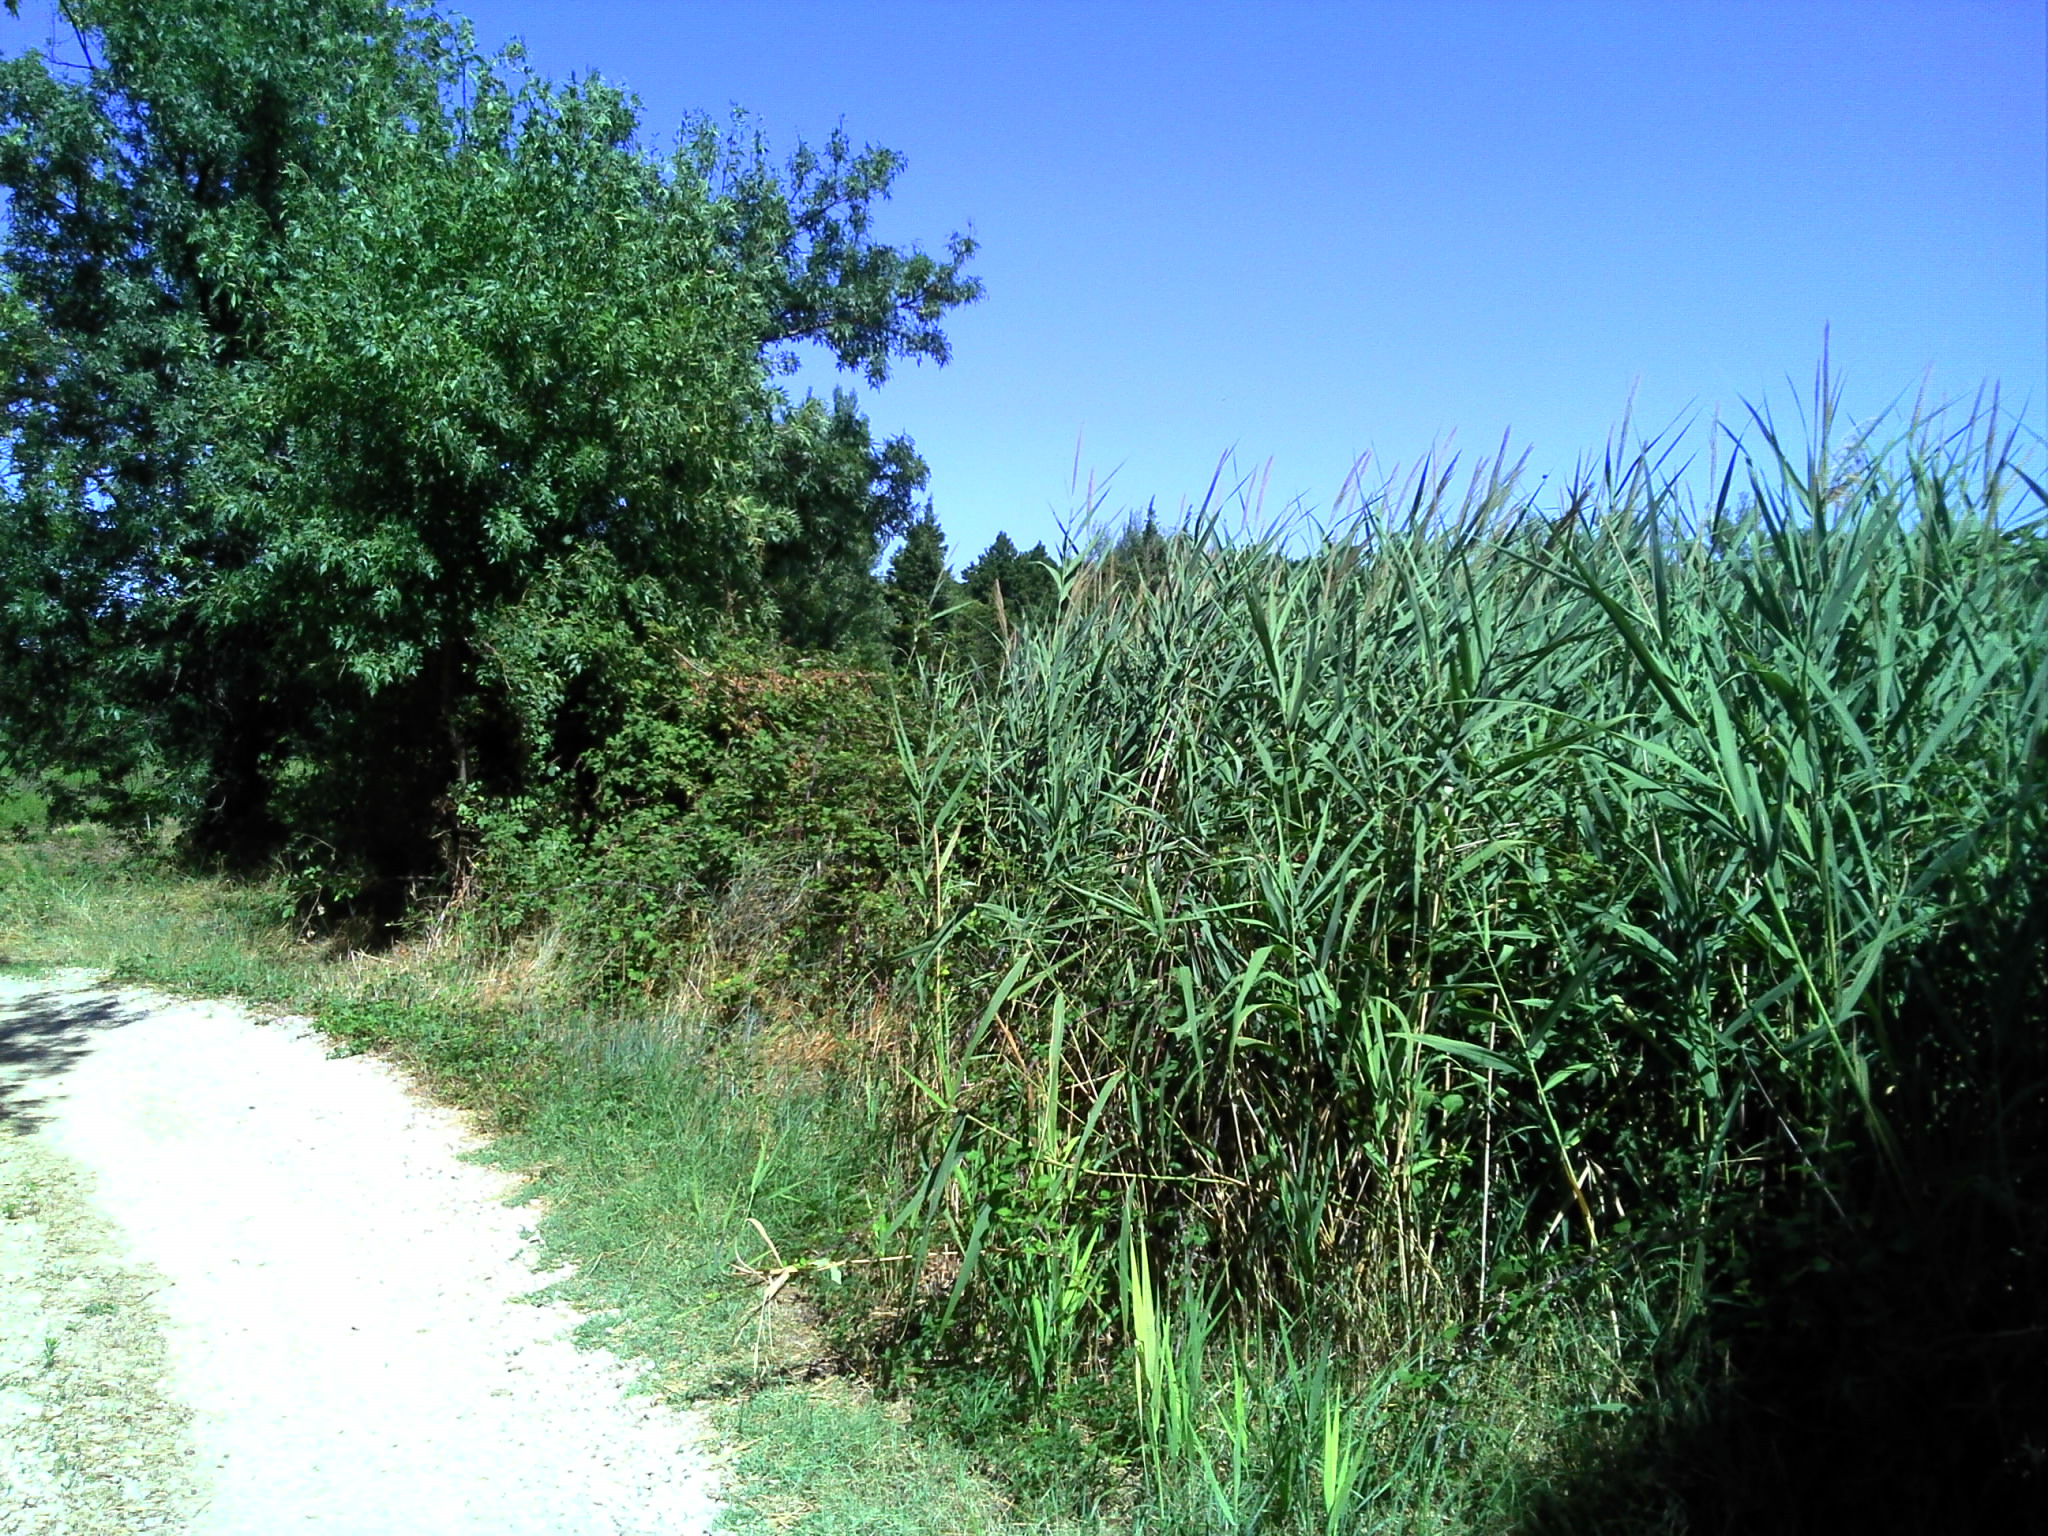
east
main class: Woodland
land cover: Broadleaved woodland
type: broadleaved evergreen forest
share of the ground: > 75 %
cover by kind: broadleaved forest trees 70 %, herbaceous plants 20 %, consolidated bare surface 10 %
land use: Semi-natural and natural areas not in use
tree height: > 5 m
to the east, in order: Tracks; Spontaneously vegetated surfaces; Ditches and canals; Grass margins; Vineyards; Other bare soil; Ditches and canals; Spontaneously vegetated surfaces; Tracks; Spontaneously vegetated surfaces; Other fresh vegetables; Lines of trees; Broadleaved woodland; Other bare soil; Railways; Other bare soil; Pine dominated mixed woodland
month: August
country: FR
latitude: 43.9999
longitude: 4.7332
